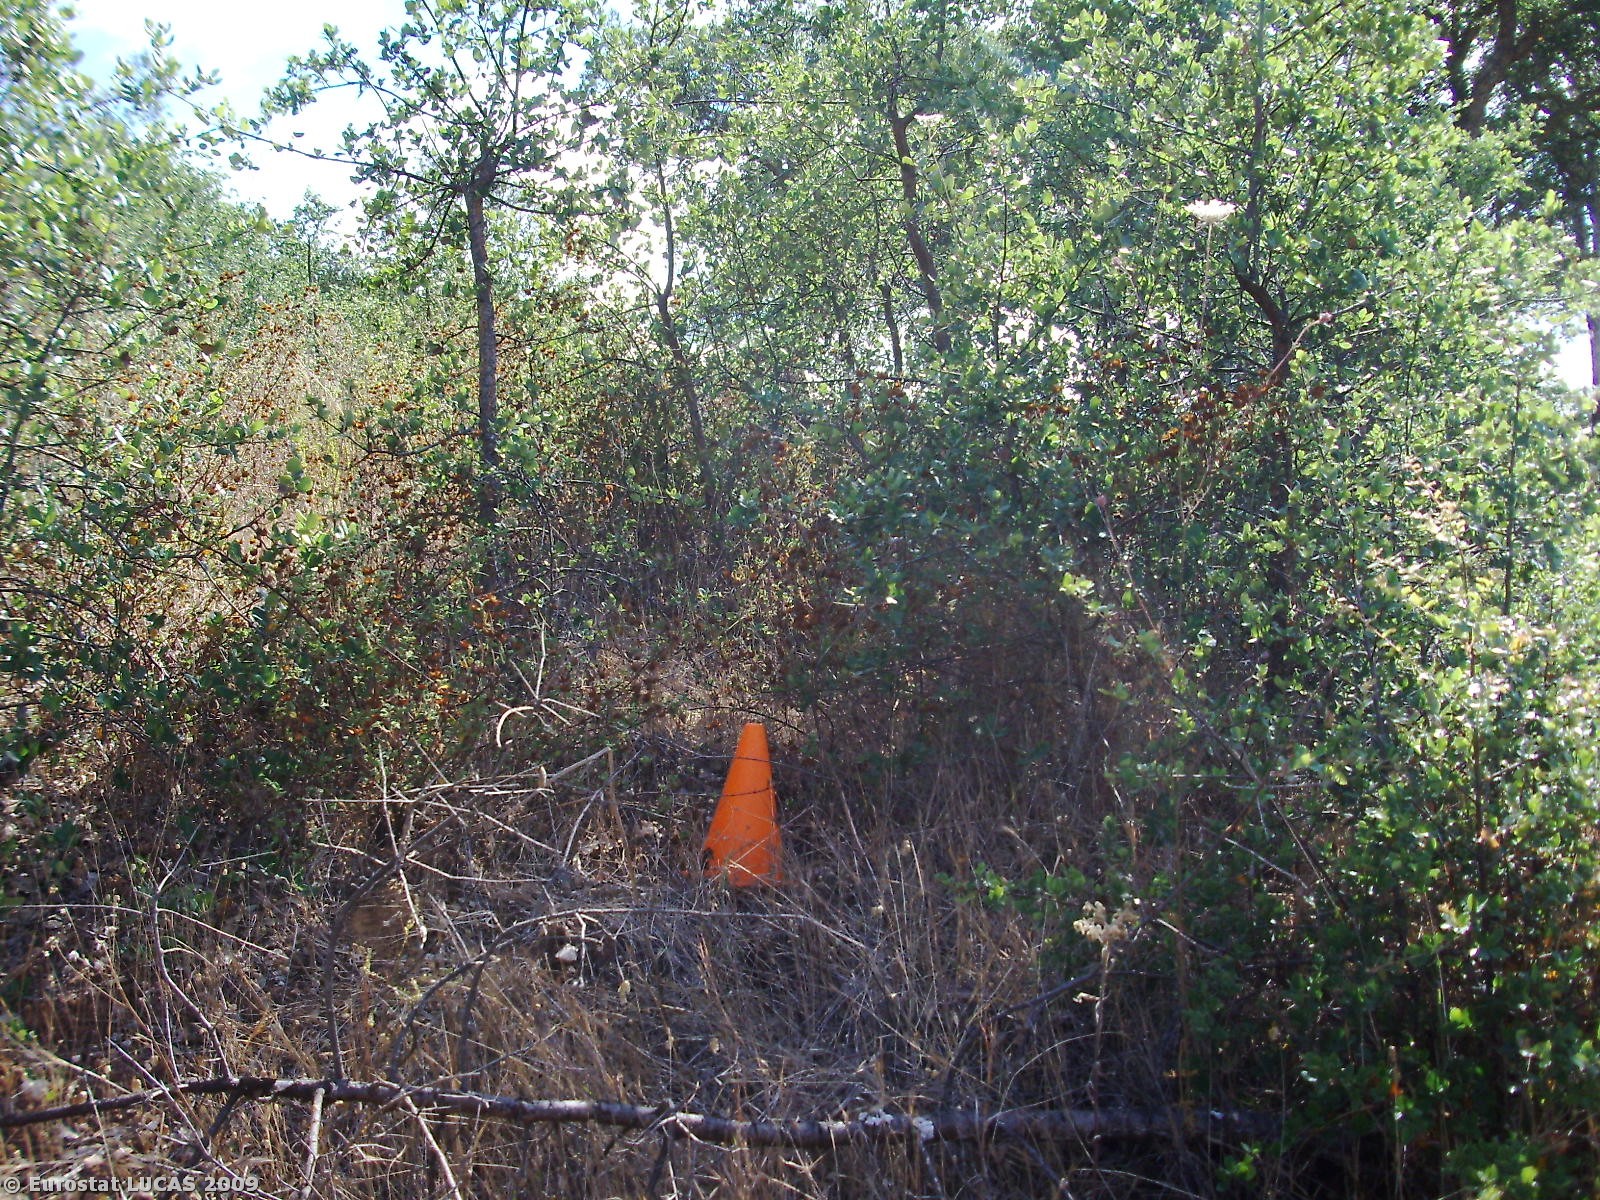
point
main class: Woodland
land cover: Broadleaved woodland
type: broadleaved evergreen forest
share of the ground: 10 - 25 %
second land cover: Shrubland with sparse tree cover
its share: 25 - 50 %
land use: Forestry
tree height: > 5 m
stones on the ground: 25 - 50 %
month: June
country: PT
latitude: 37.8019
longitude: -8.5179
